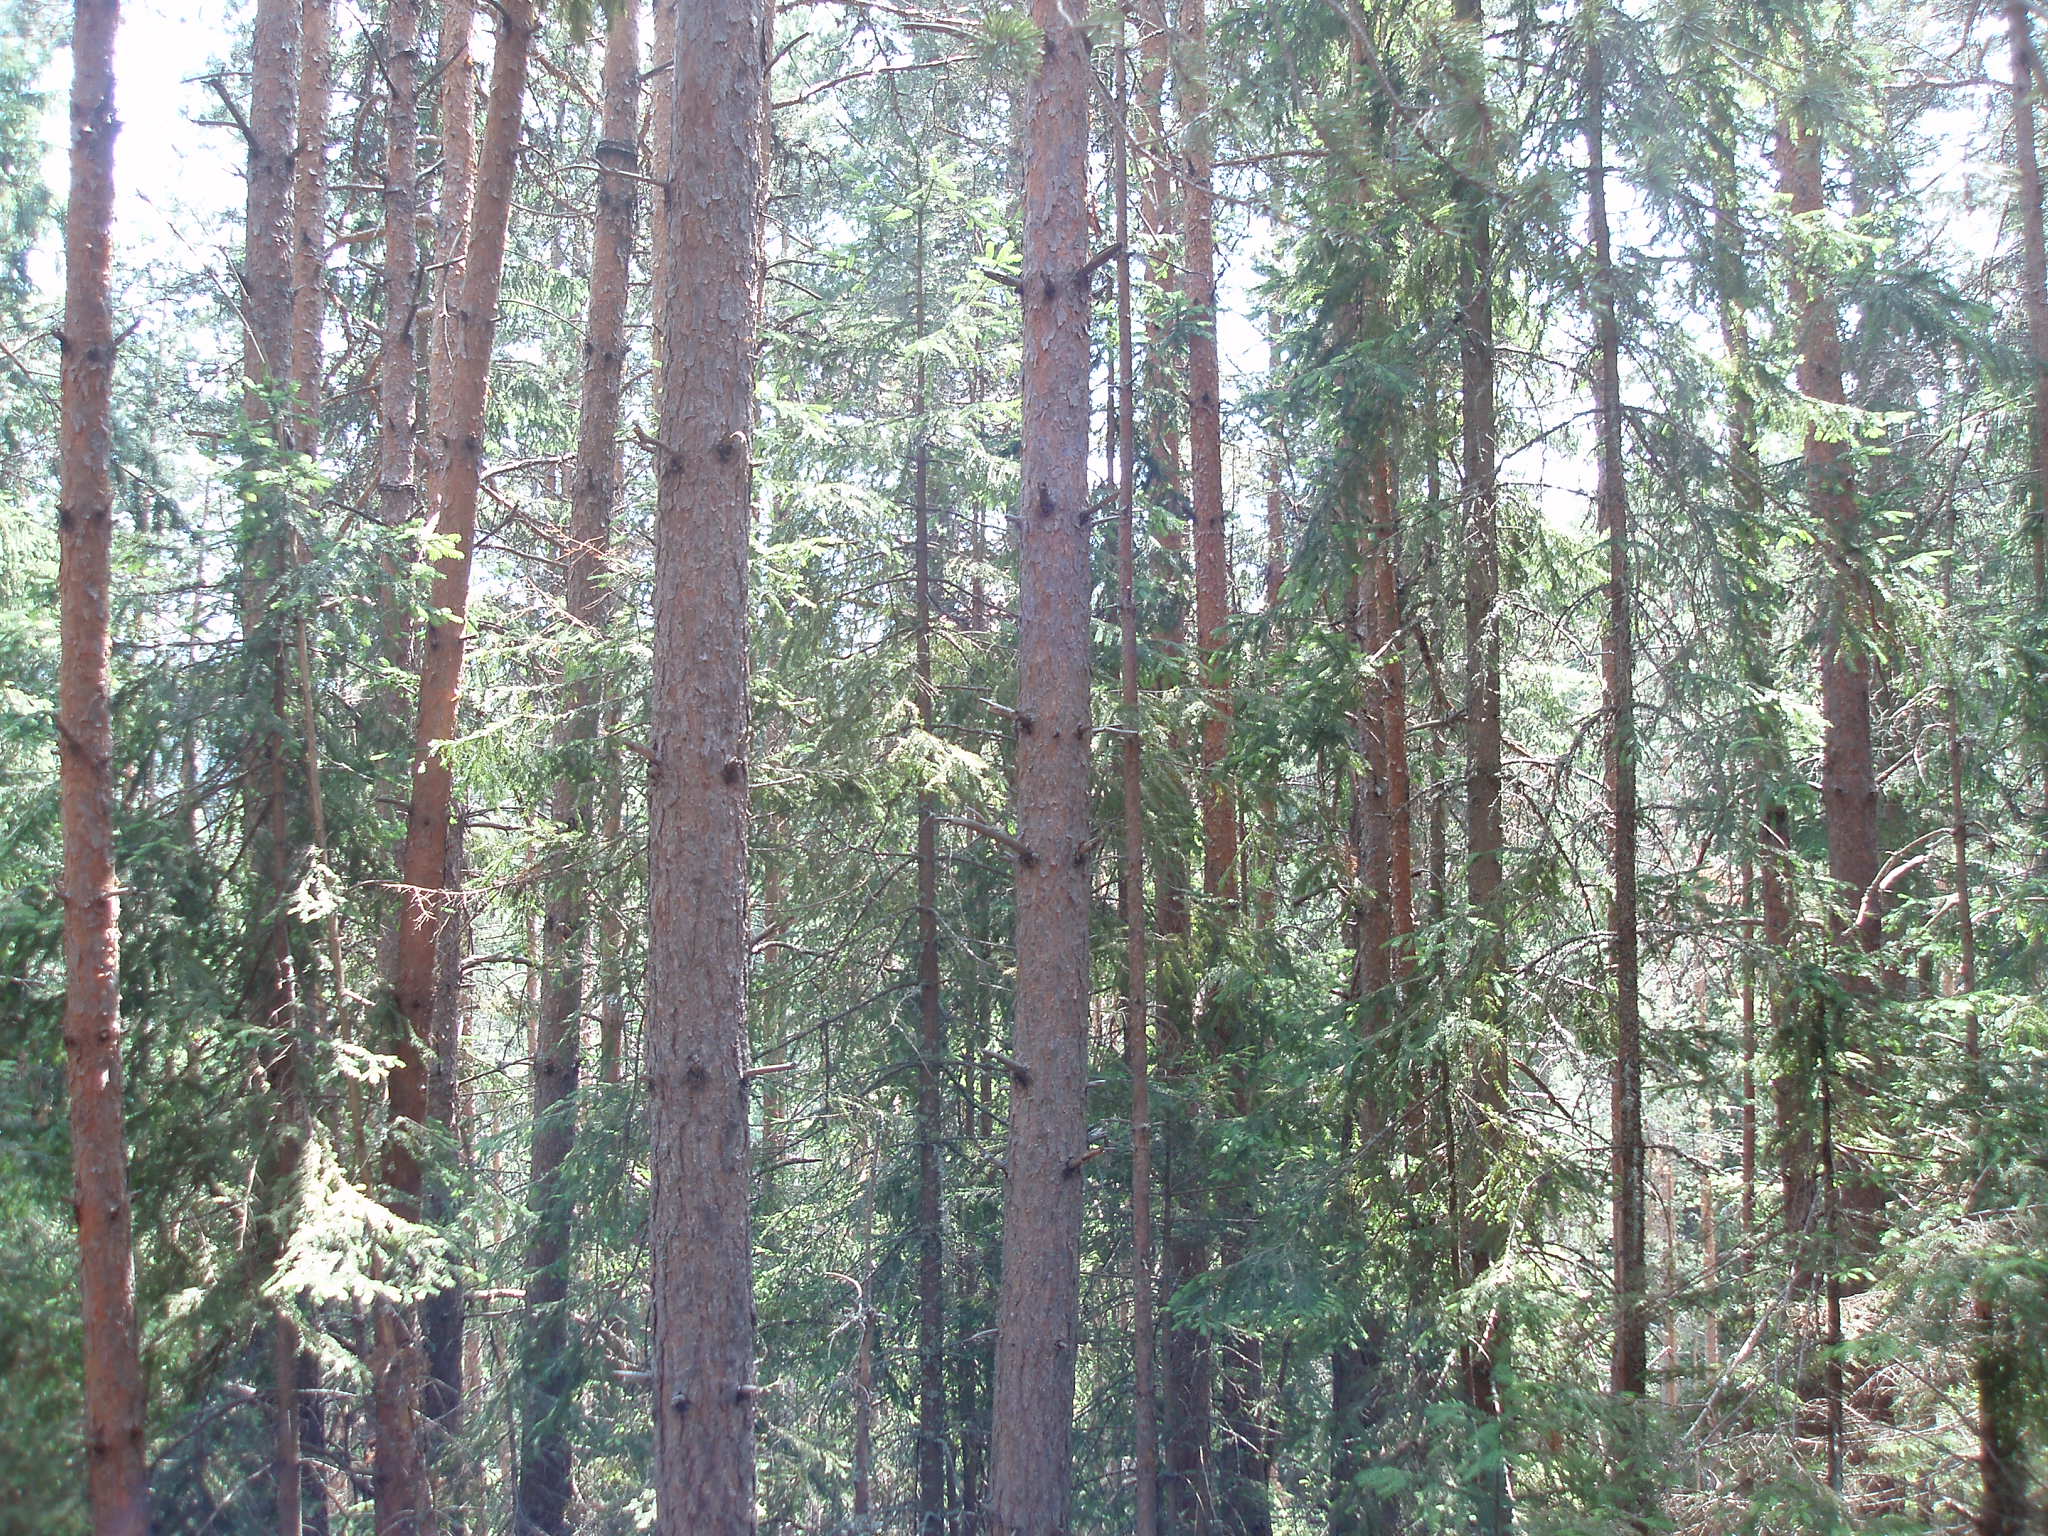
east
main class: Woodland
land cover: Spruce dominated coniferous woodland
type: hemiboreal forest and nemoral coniferous forest and mixed broadleaved-coniferous forest
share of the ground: > 75 %
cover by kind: coniferous forest trees 95 %, unconsolidated bare surface 5 %
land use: Forestry
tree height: > 5 m
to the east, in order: Spruce dominated coniferous woodland; Tracks; Pine dominated coniferous woodland
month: July
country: BG
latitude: 41.9992
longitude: 23.7846
